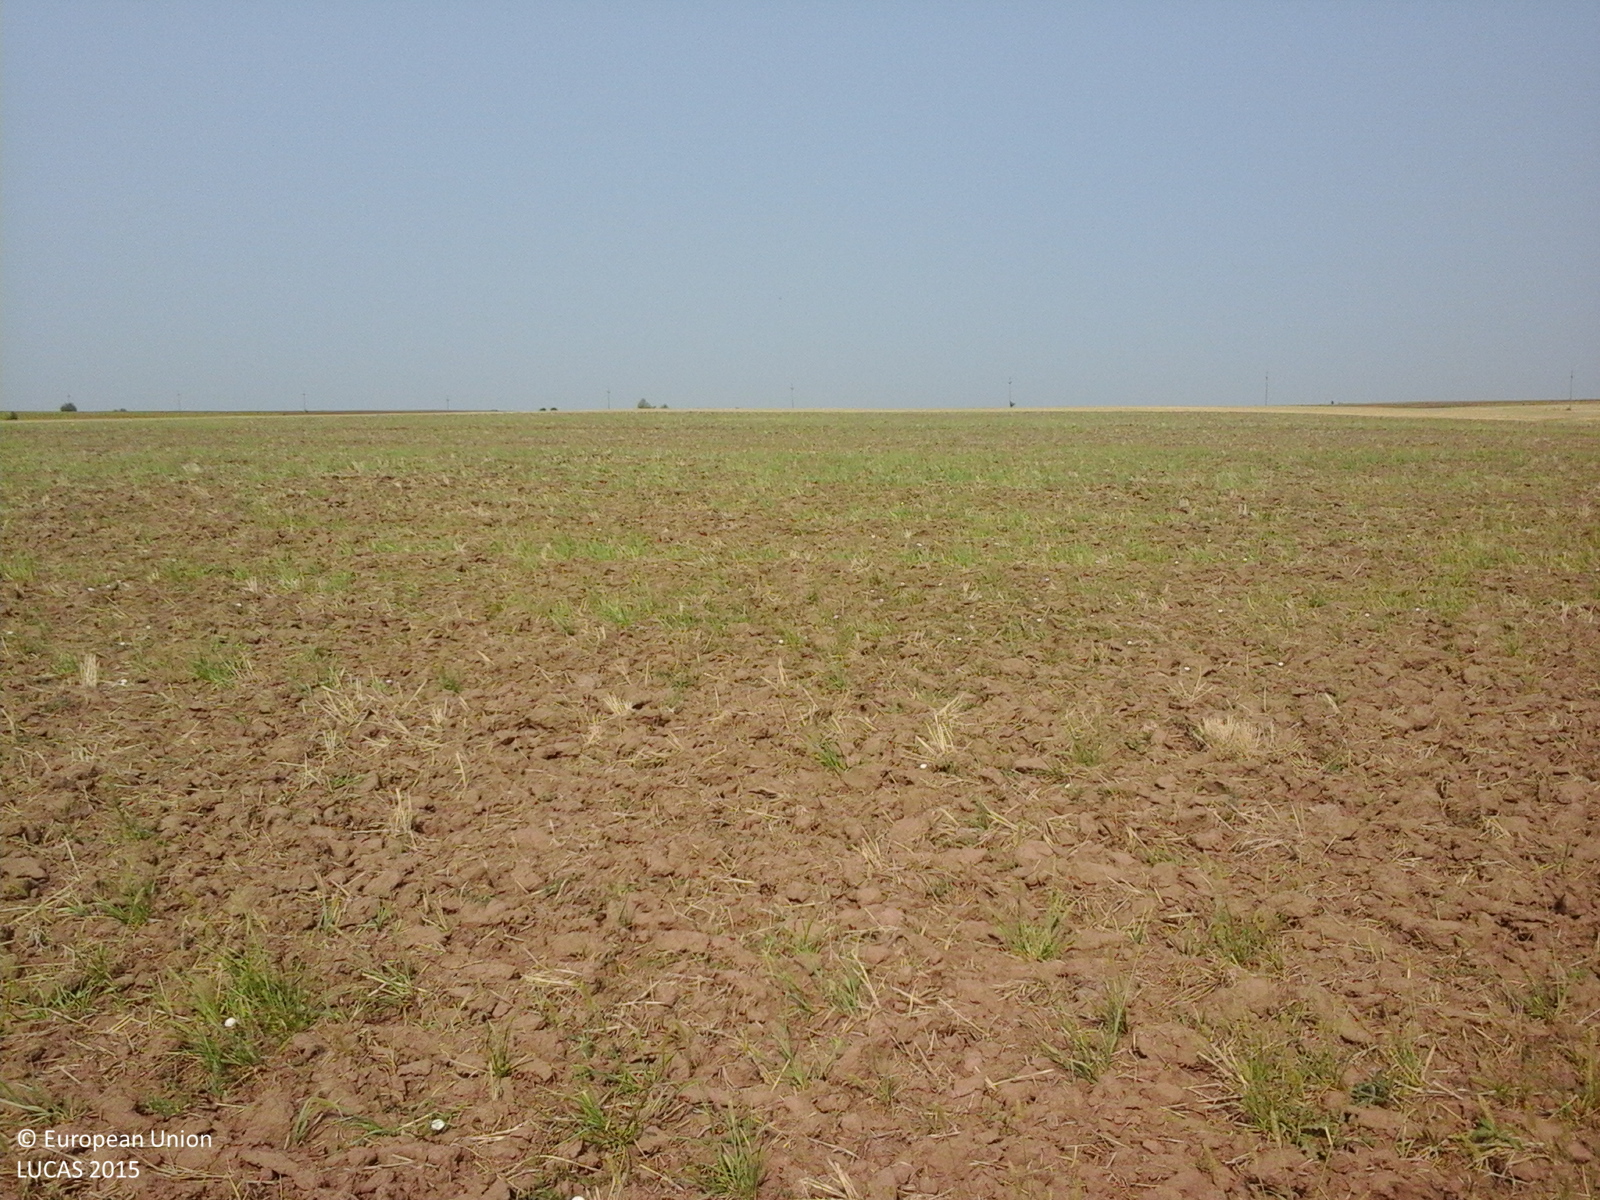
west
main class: Cropland
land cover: Durum wheat
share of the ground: 25 - 50 %
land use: Agriculture (excluding fallow land and kitchen gardens)
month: August
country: RO
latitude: 44.2683
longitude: 23.4933
